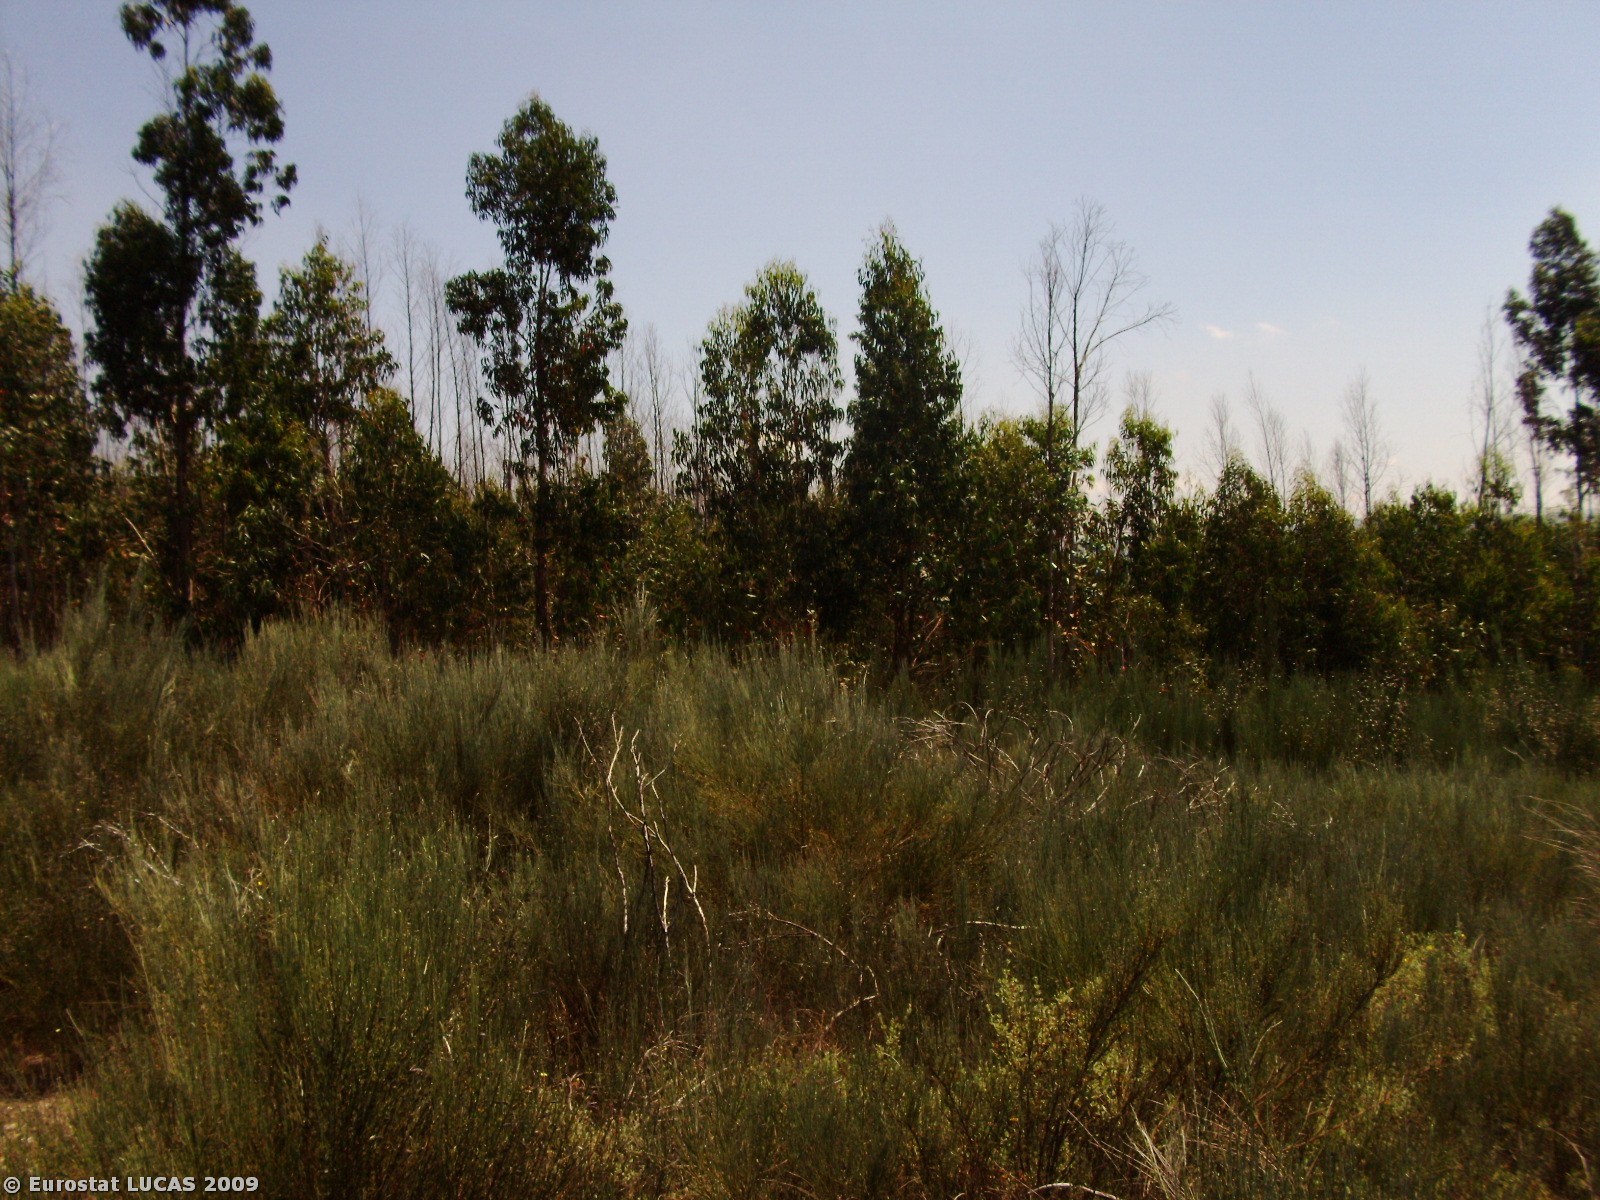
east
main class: Shrubland
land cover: Shrubland without tree cover
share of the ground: > 75 %
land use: Unused
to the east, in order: Shrubland without tree cover; Dry stone walls; Broadleaved woodland; Shrubland without tree cover; Dry stone walls; Shrubland without tree cover; Shrubland with sparse tree cover
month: July
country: PT
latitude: 40.6501
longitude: -7.6314
